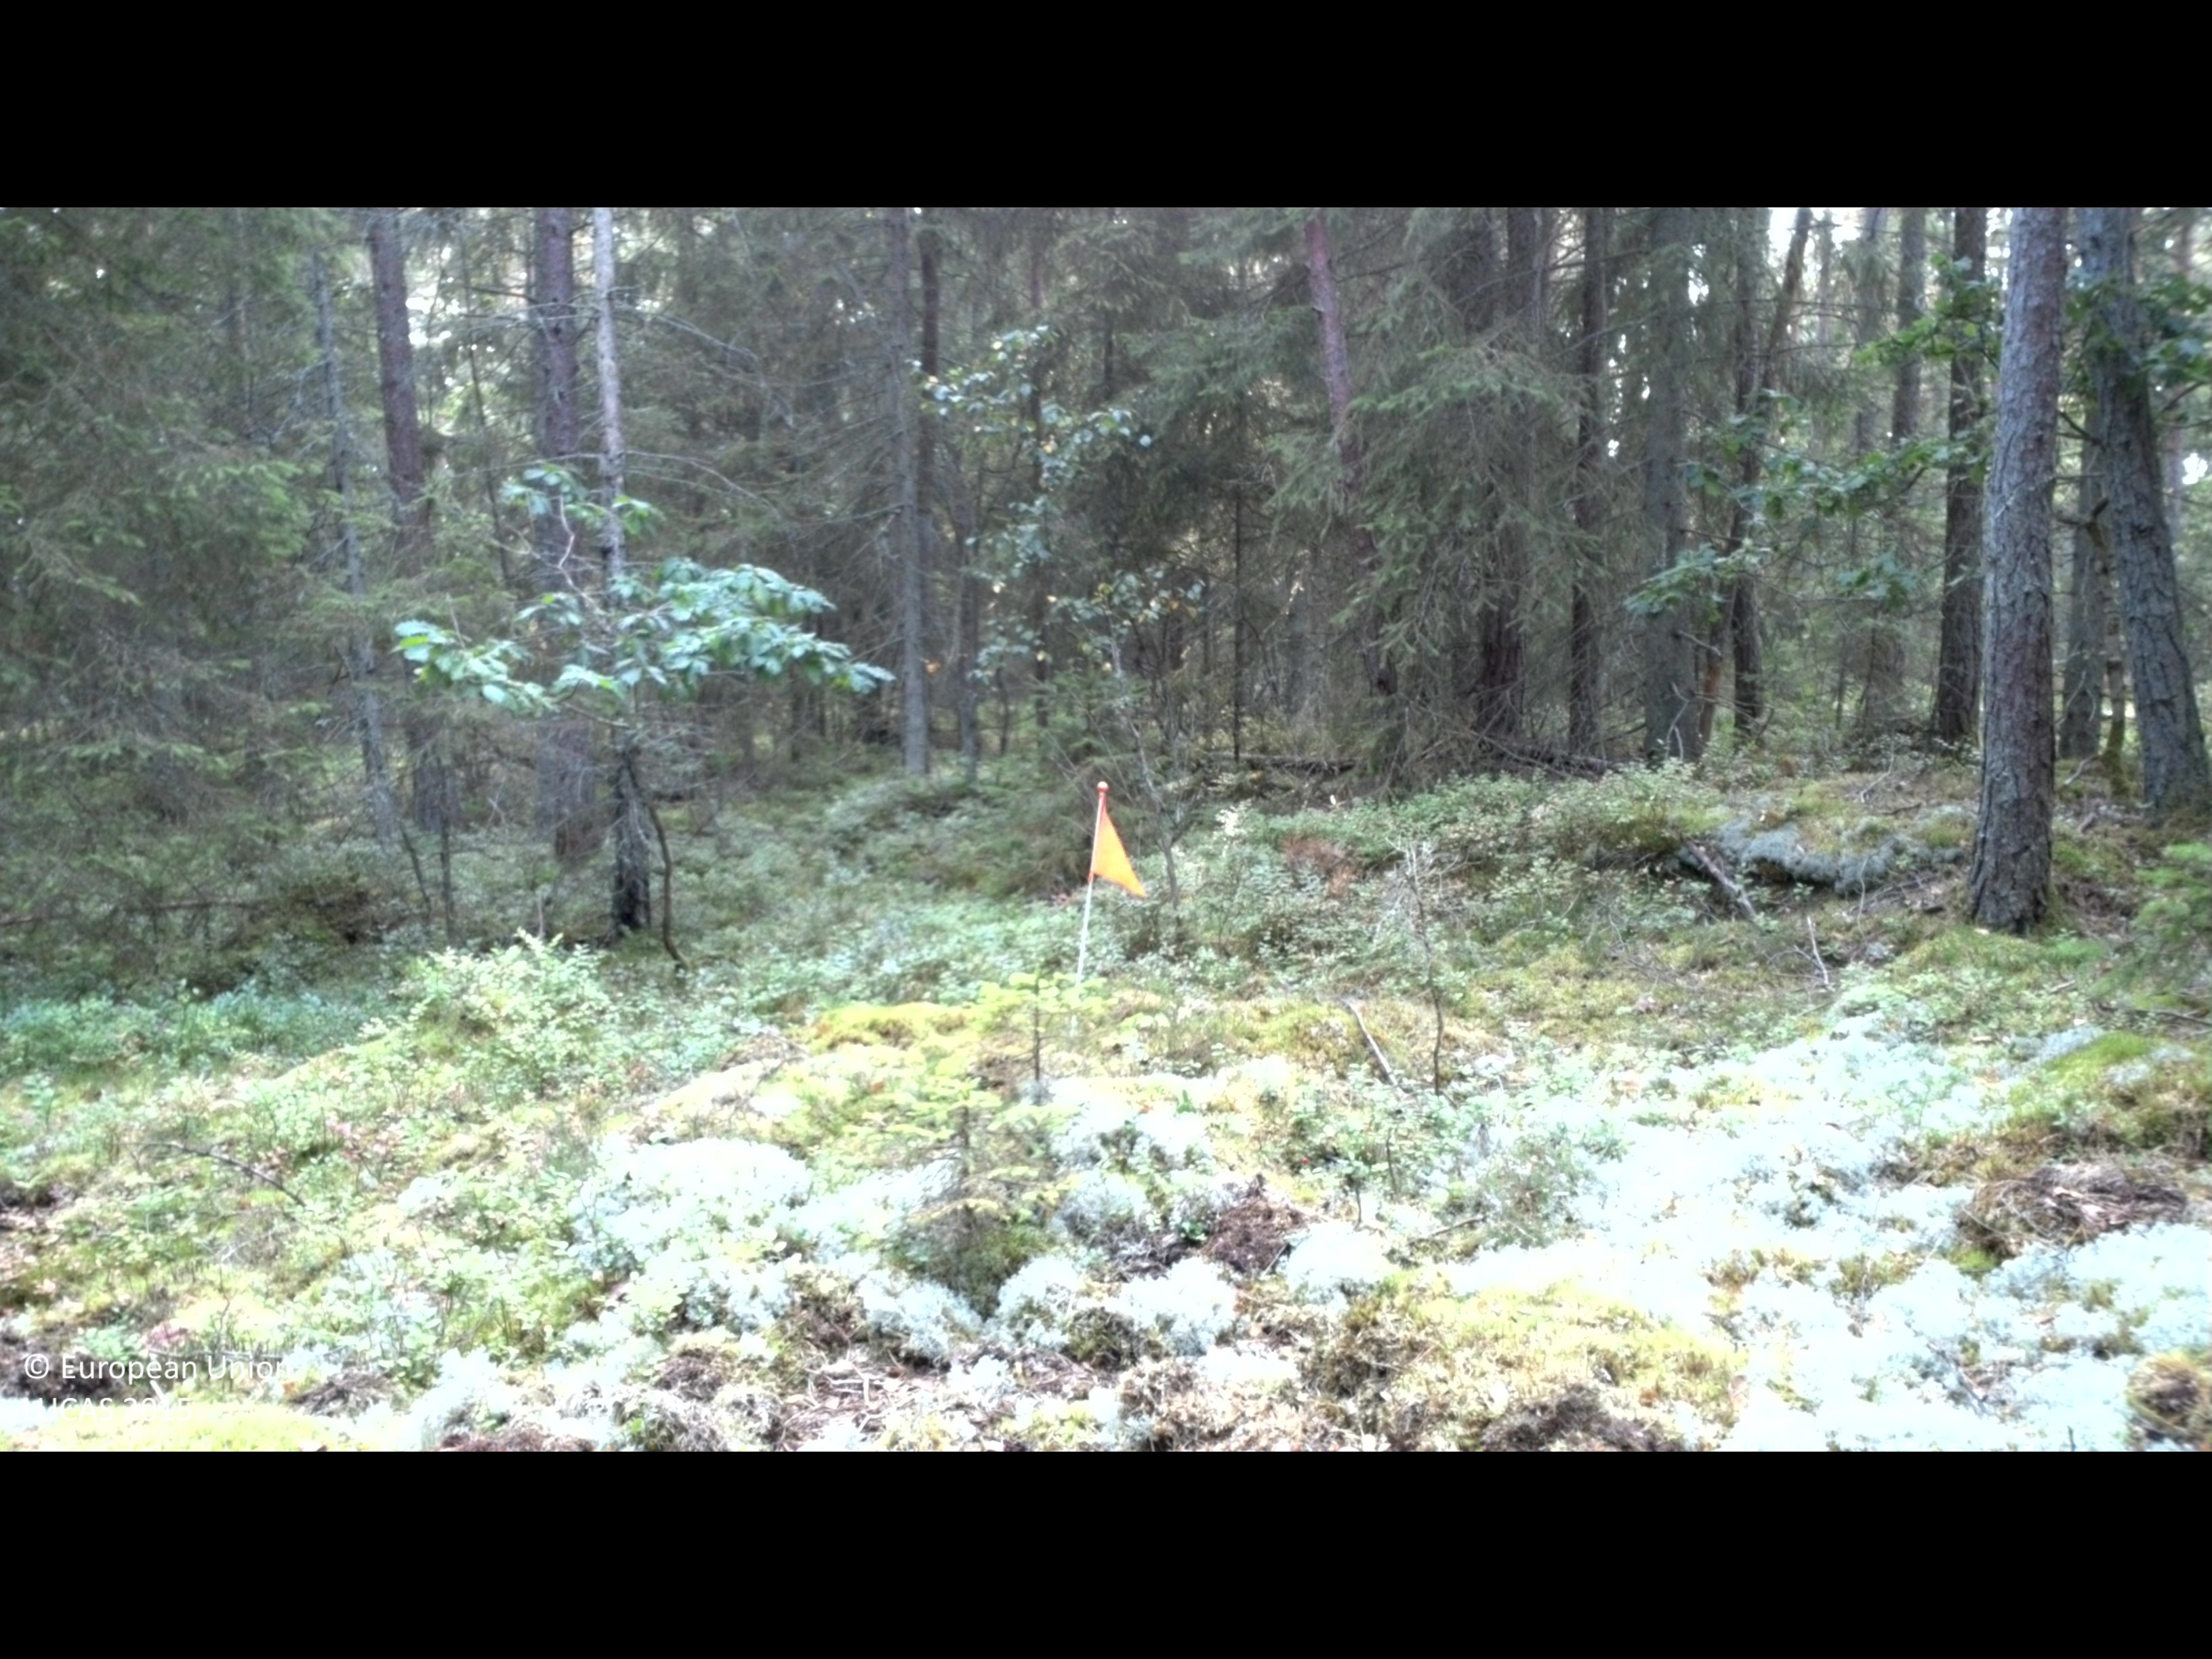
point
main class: Woodland
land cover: Spruce dominated coniferous woodland
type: boreal forest
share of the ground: 25 - 50 %
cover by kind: lichens and mosses 50 %, coniferous forest trees 35 %, shrubs 15 %
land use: Forestry
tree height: > 5 m
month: August
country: SE
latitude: 56.1725
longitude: 15.2015
